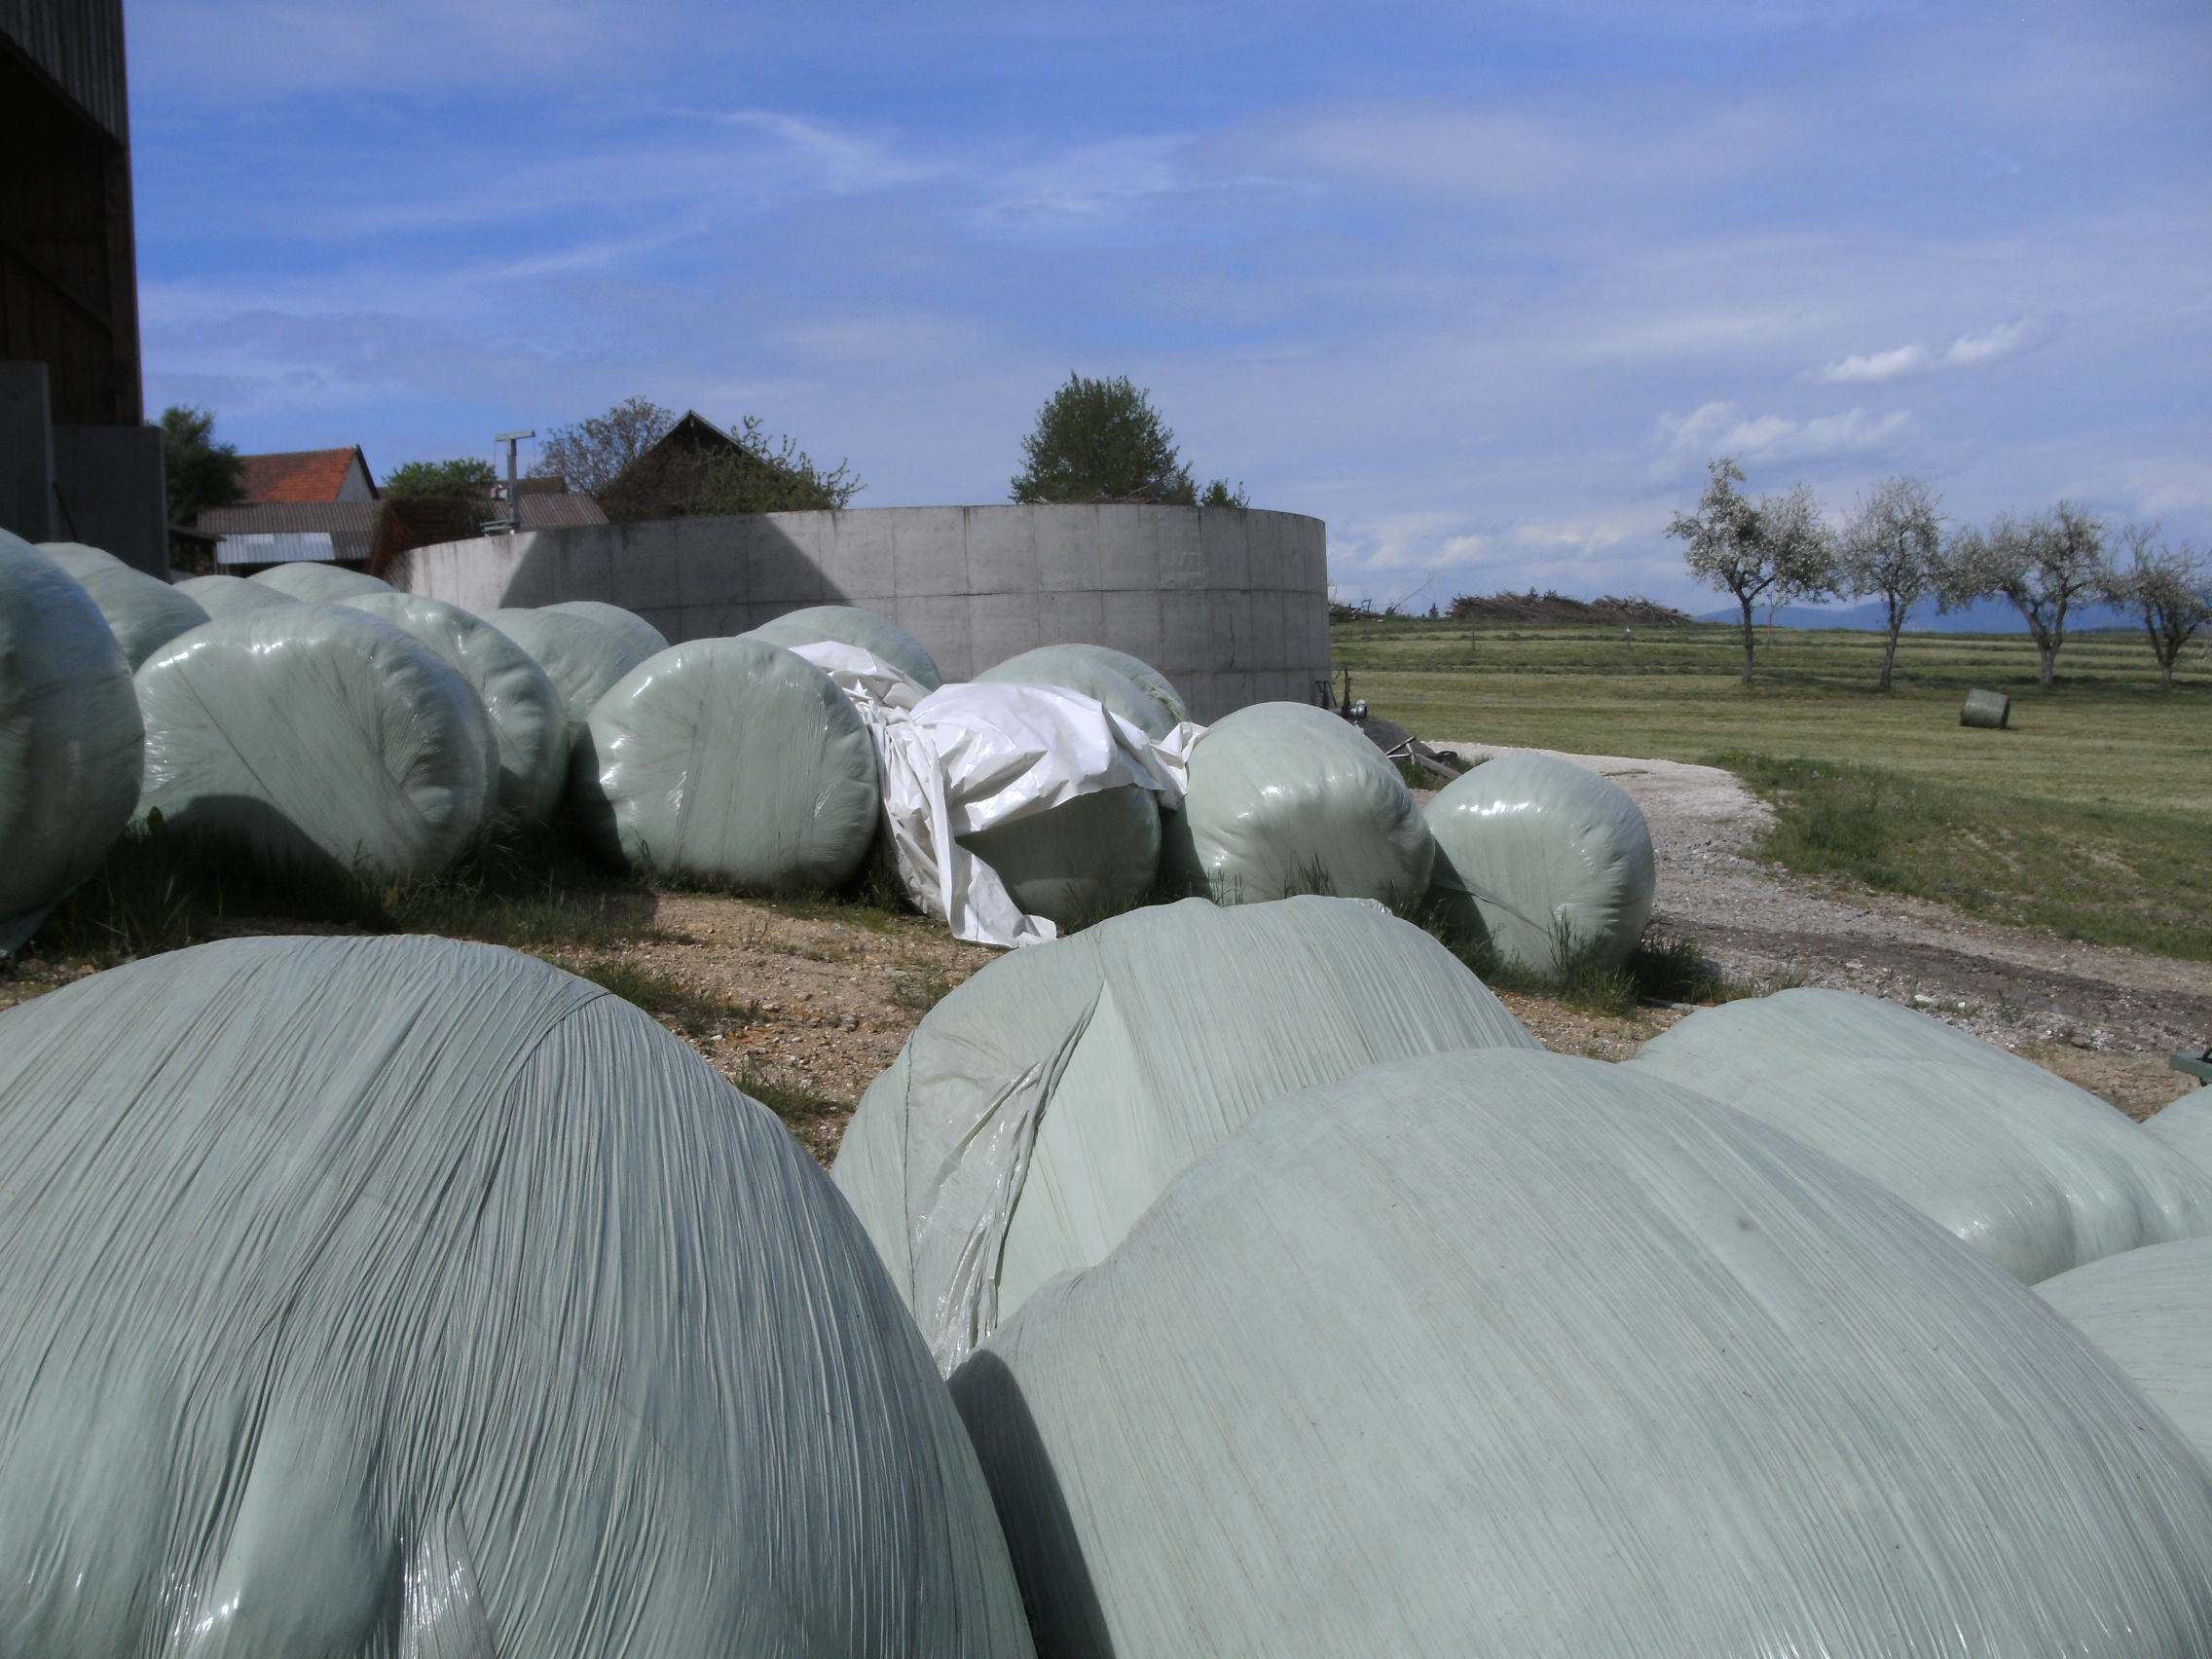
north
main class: Grassland
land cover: Spontaneously vegetated surfaces
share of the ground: 10 - 25 %
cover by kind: consolidated bare surface 30 %, herbaceous plants 15 %
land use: Agriculture (excluding fallow land and kitchen gardens)
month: May
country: AT
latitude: 48.5451
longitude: 13.5351
